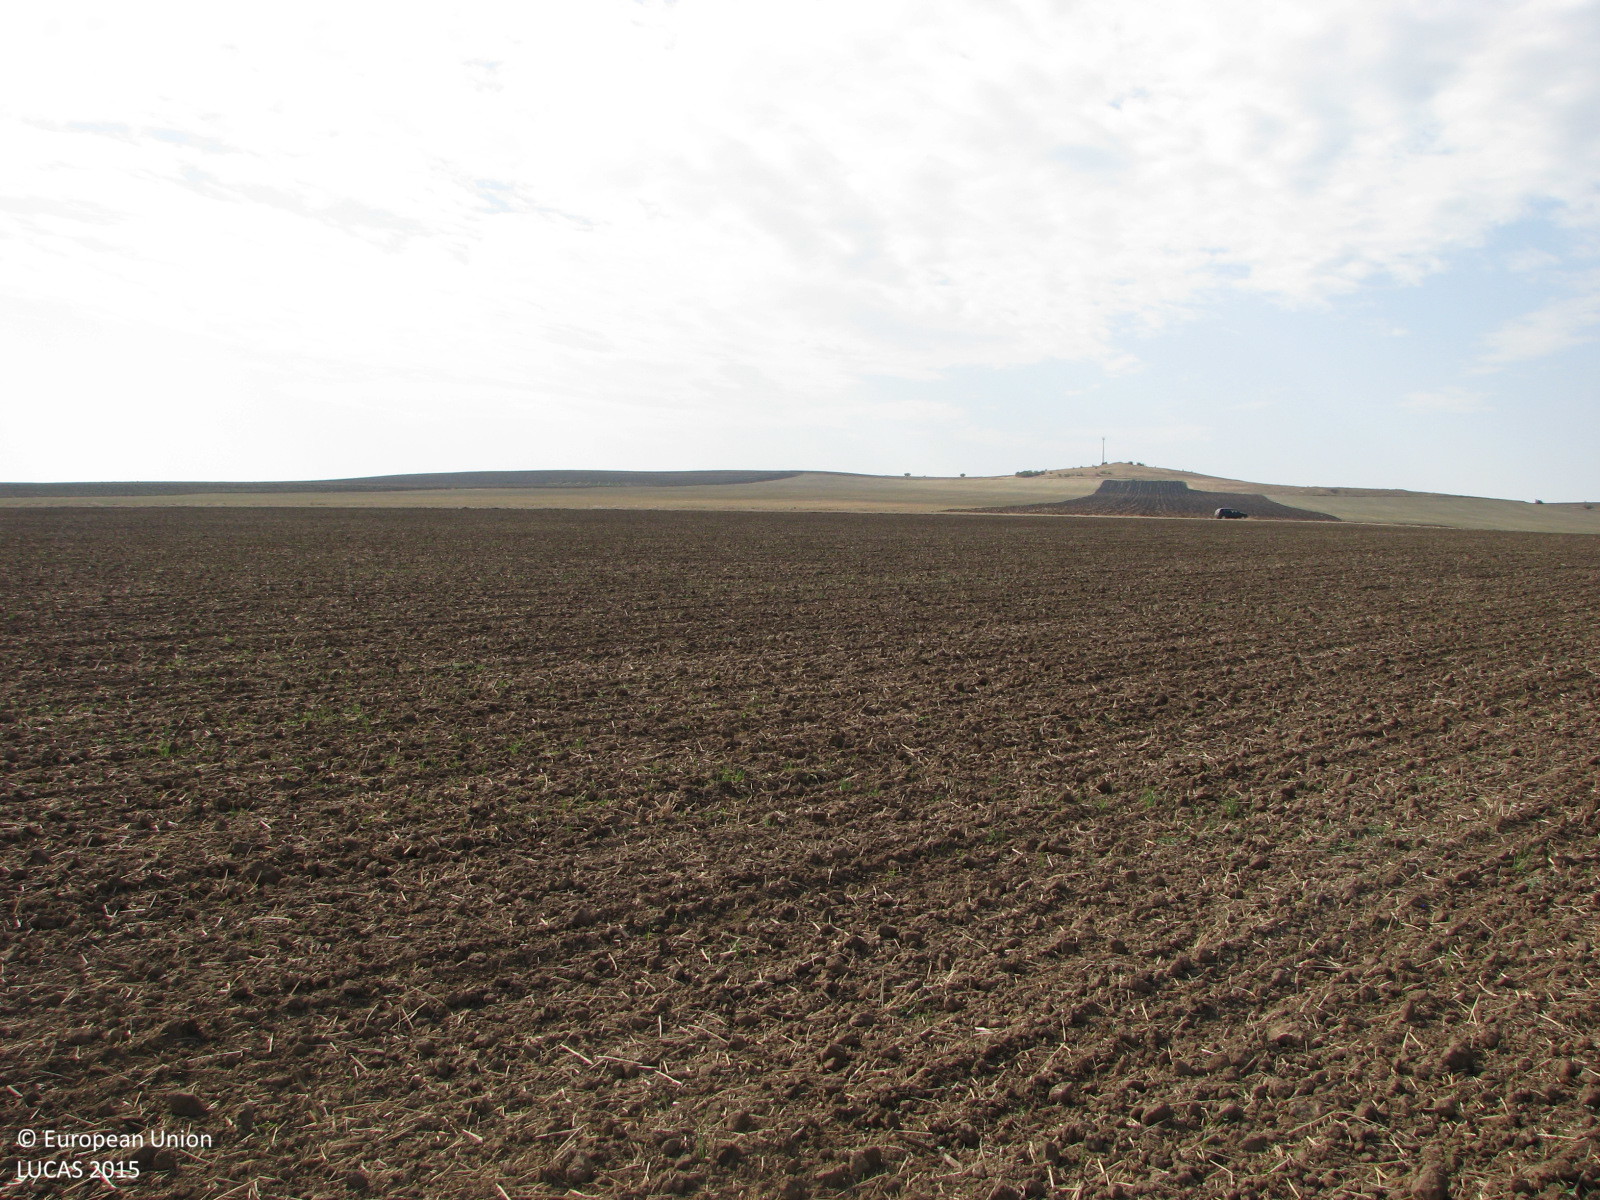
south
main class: Cropland
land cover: Common wheat
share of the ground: < 10 %
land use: Agriculture (excluding fallow land and kitchen gardens)
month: September
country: BG
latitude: 42.5707
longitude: 26.2034
